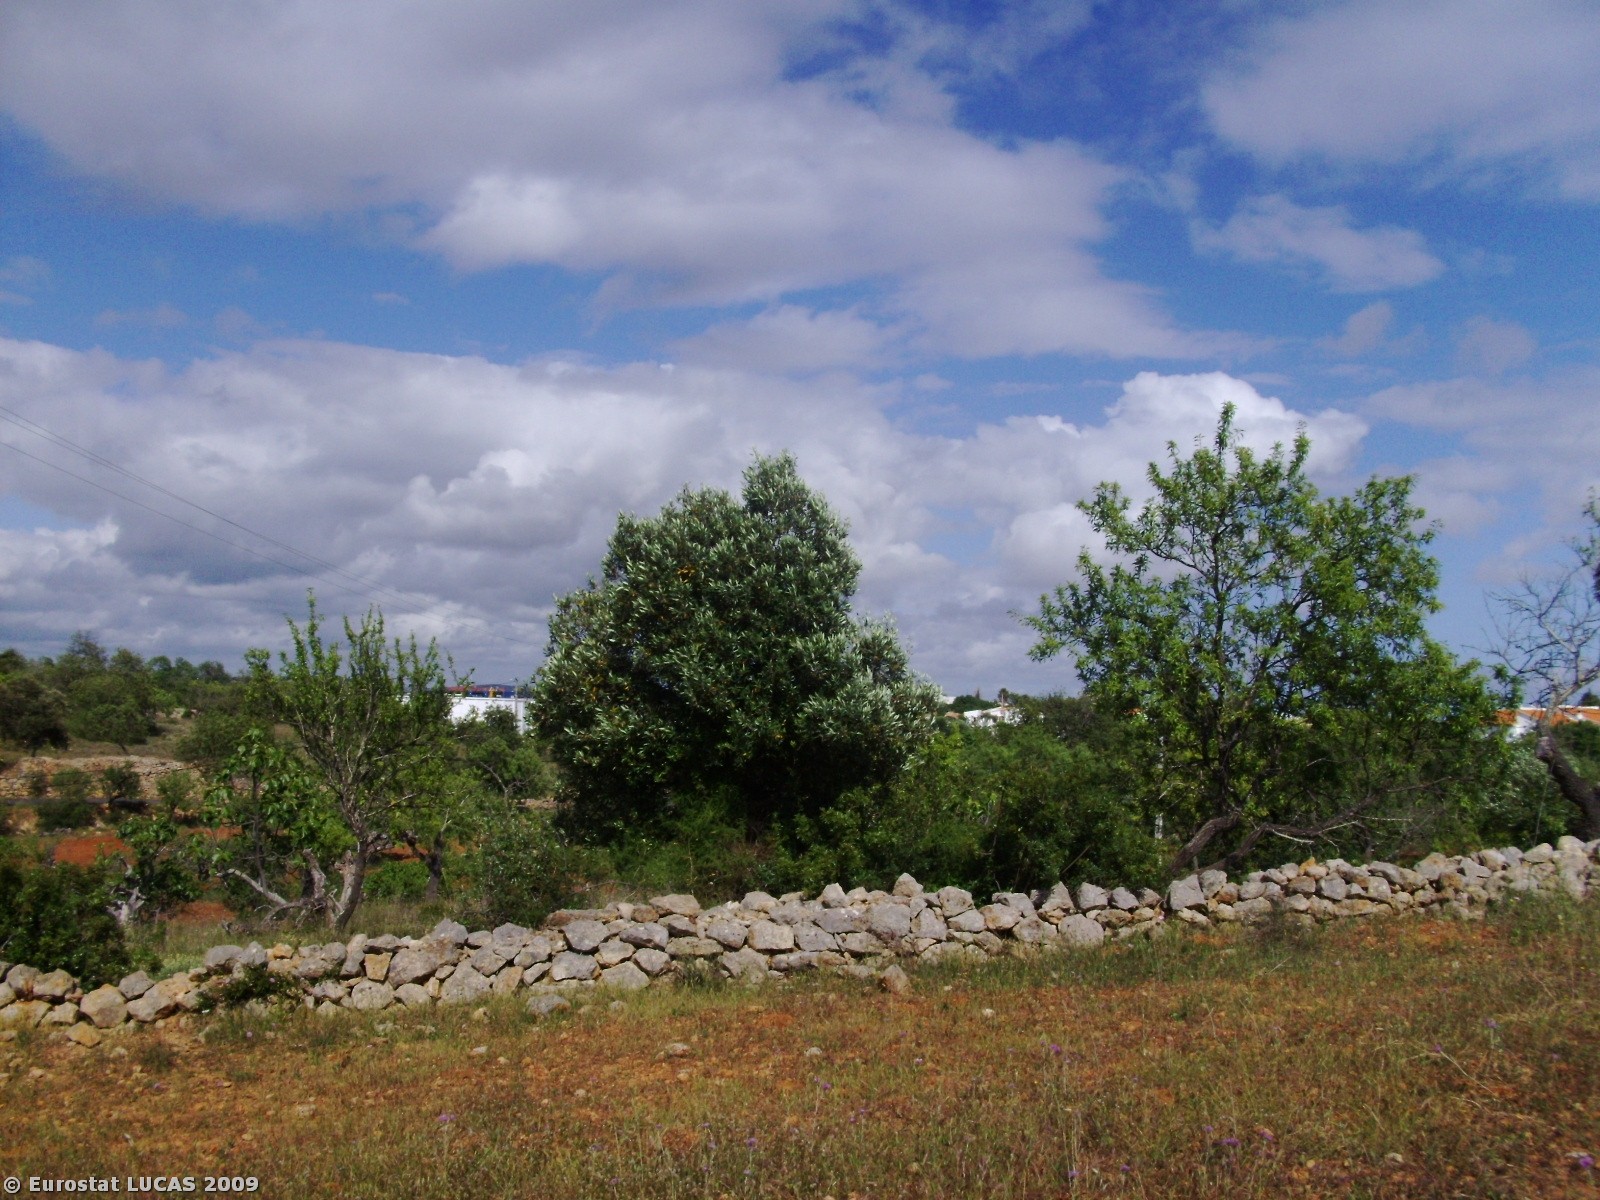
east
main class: Cropland
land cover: Nuts trees
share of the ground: 10 - 25 %
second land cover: Spontaneously vegetated surfaces
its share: 50 - 75 %
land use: Agriculture (excluding fallow land and kitchen gardens)
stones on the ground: 10 - 25 %
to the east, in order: Nuts trees; Spontaneously vegetated surfaces; Dry stone walls; Permanent industrial crops; Dry stone walls; Electric lines; Permanent industrial crops; Tracks; Electric lines; Mixed woodland; Tracks; Fences; Lines of trees; Mixed woodland; Artificial constructions in urban areas; Fences; Electric lines; Paved roads, cycling and walking lanes
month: May
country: PT
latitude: 37.1557
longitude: -8.2258
